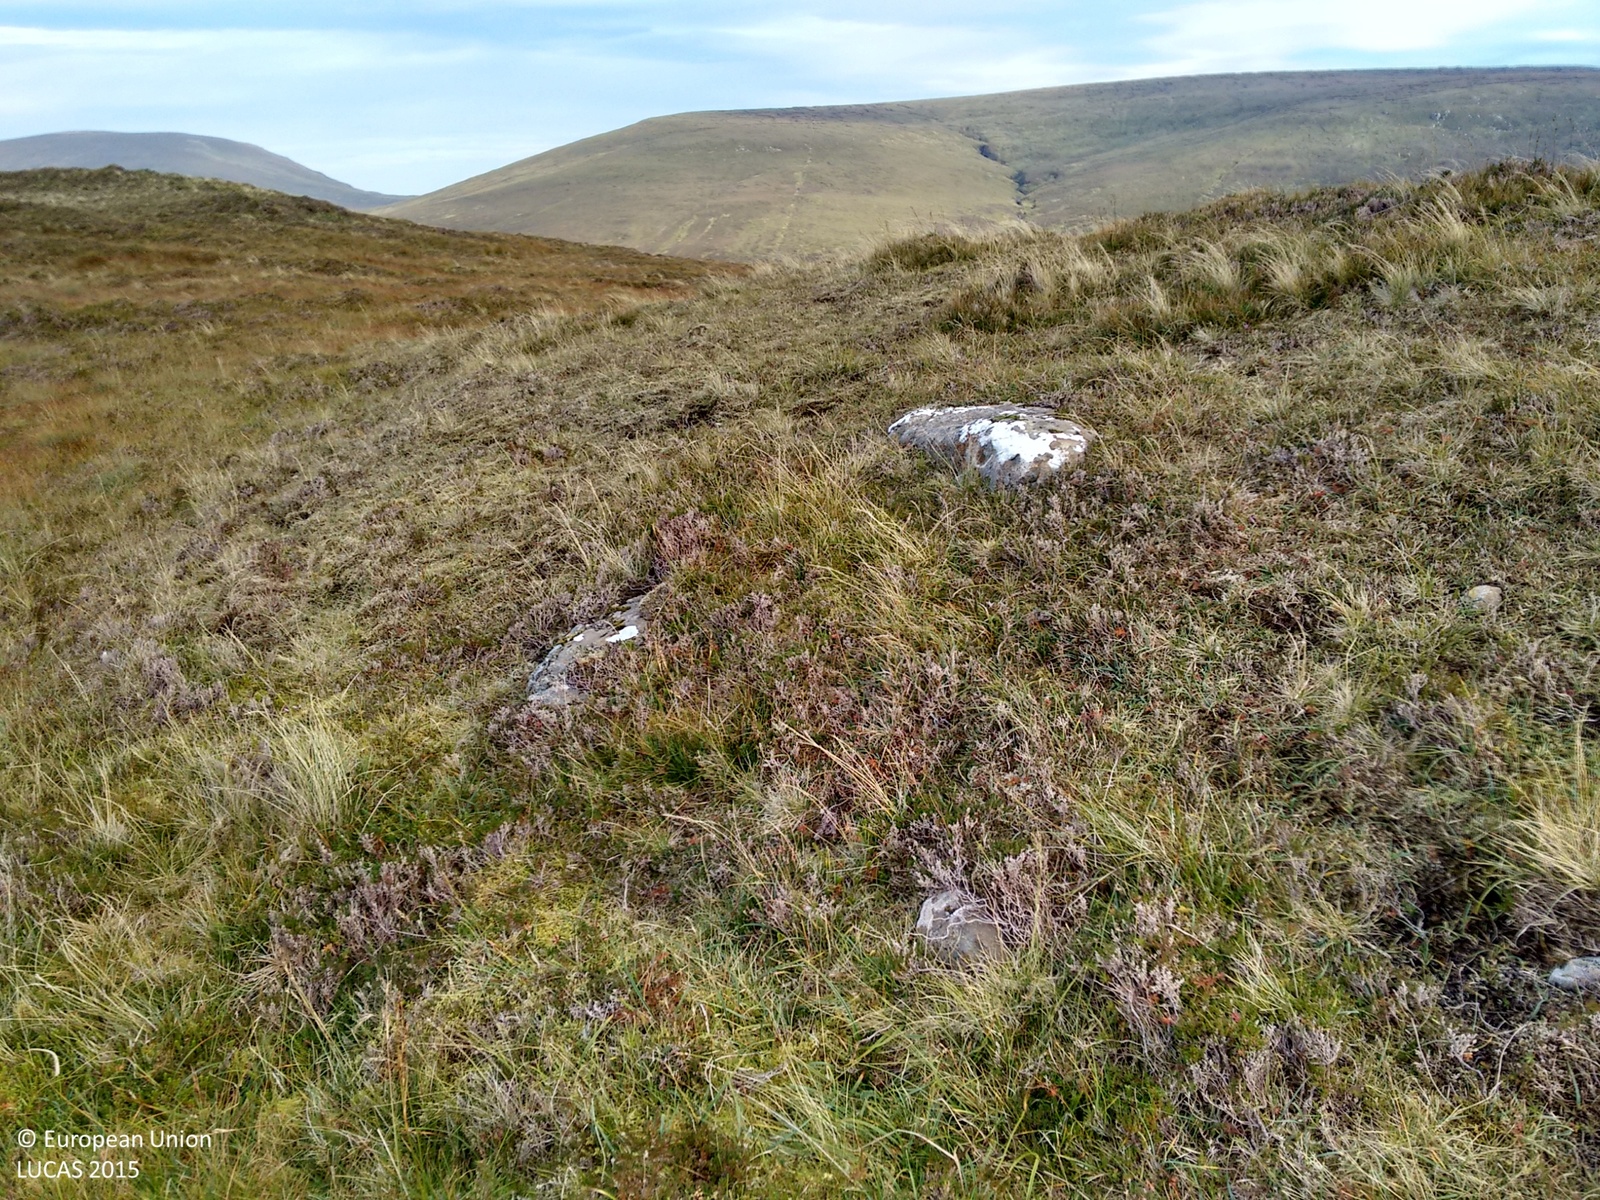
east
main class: Shrubland
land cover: Shrubland without tree cover
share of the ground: > 75 %
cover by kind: shrubs 80 %, herbaceous plants 20 %
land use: Agriculture (excluding fallow land and kitchen gardens)
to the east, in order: Shrubland without tree cover; Grassland without tree/shrub cover; Shrubland without tree cover
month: September
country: GB
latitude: 57.6118
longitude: -6.3573
